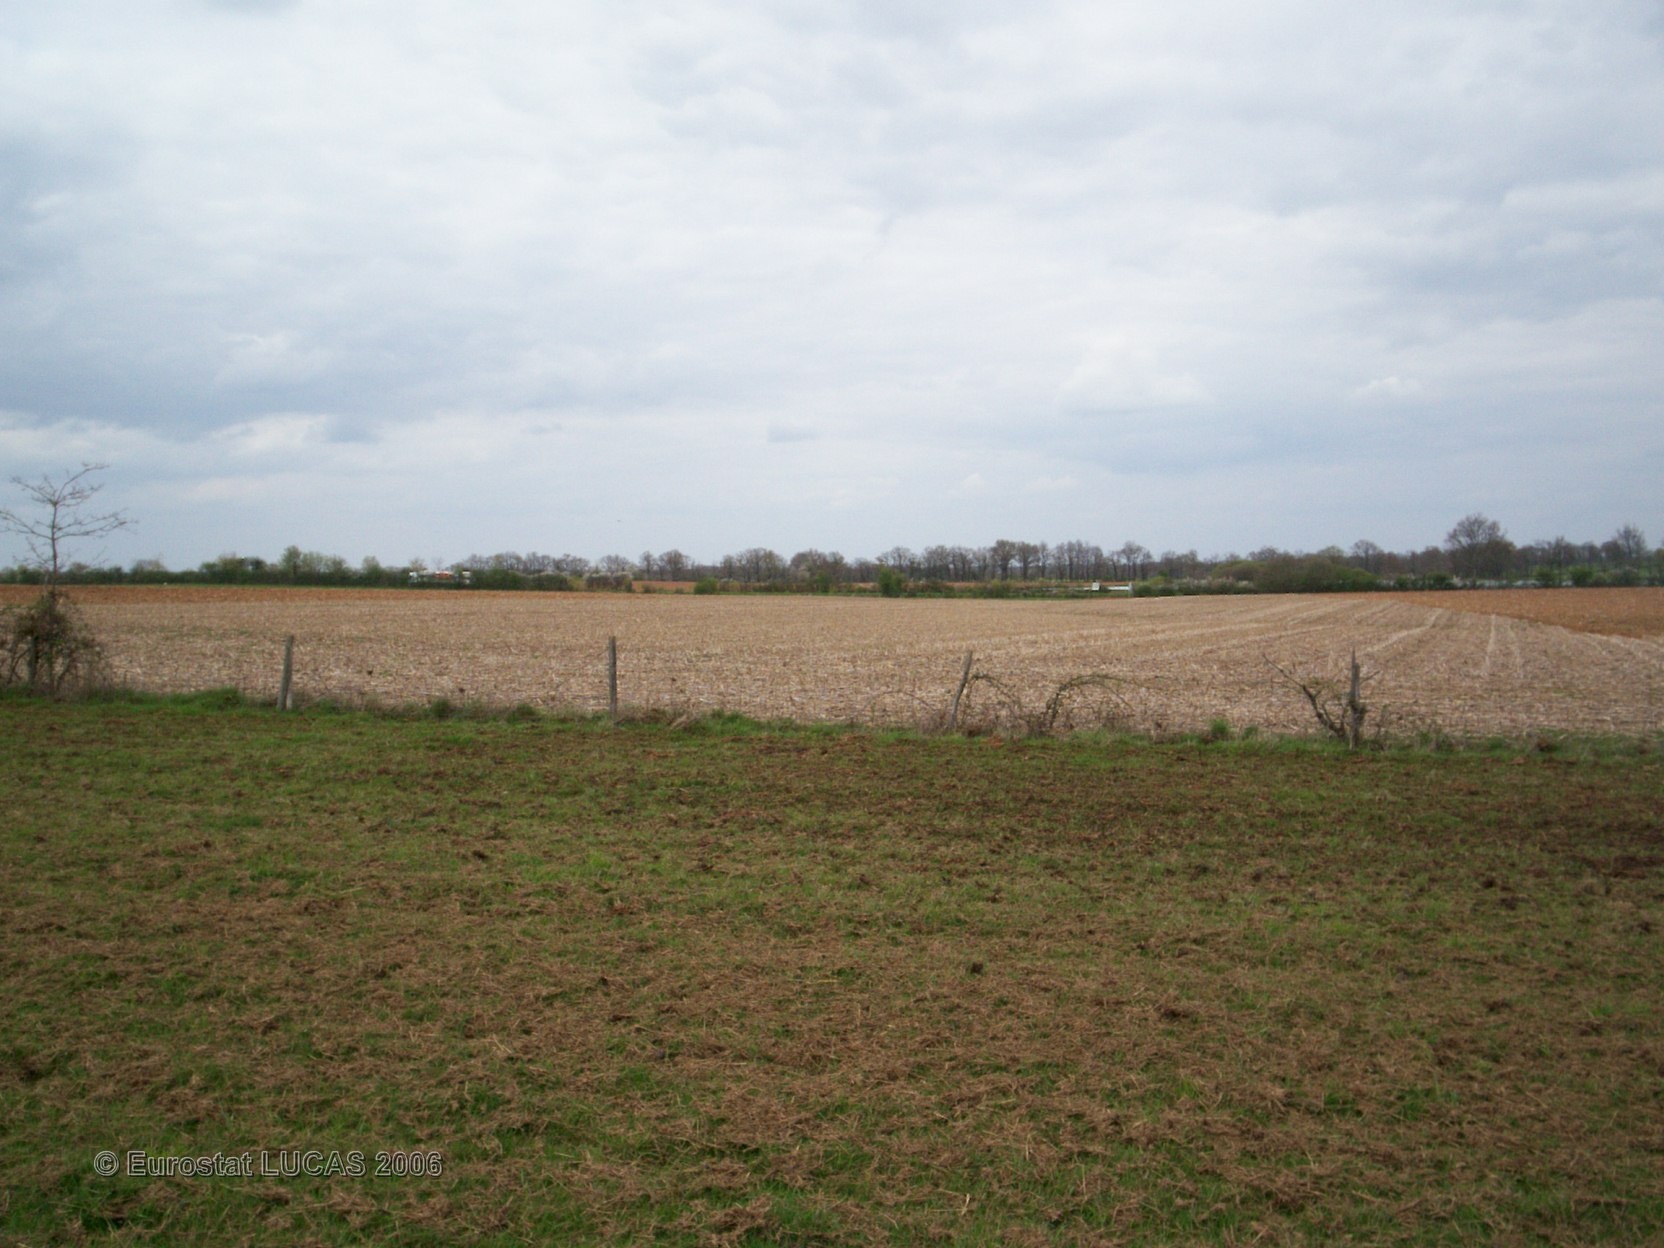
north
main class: Grassland
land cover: Grassland without tree/shrub cover
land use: Agriculture (excluding fallow land and kitchen gardens)
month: April
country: FR
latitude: 46.1135
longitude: 0.5522
